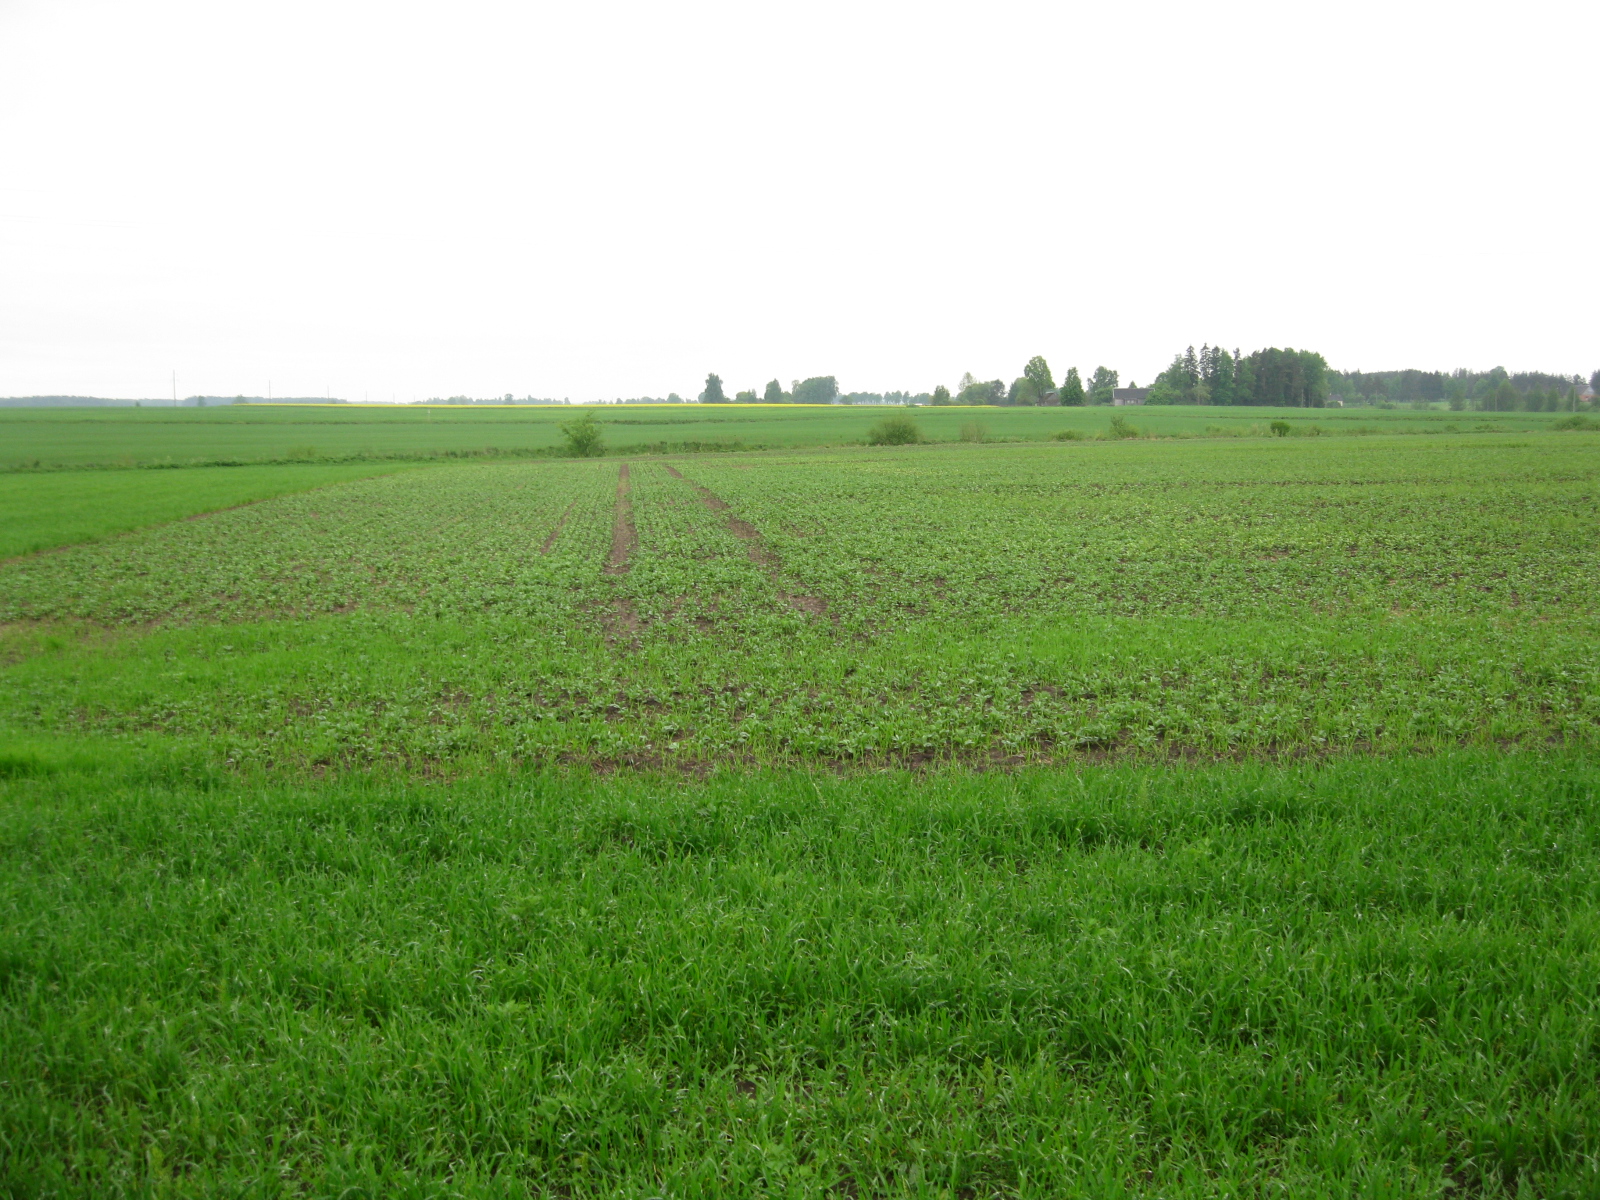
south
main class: Cropland
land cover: Common wheat
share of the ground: > 75 %
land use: Agriculture (excluding fallow land and kitchen gardens)
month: May
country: LT
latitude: 55.9062
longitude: 24.3475
